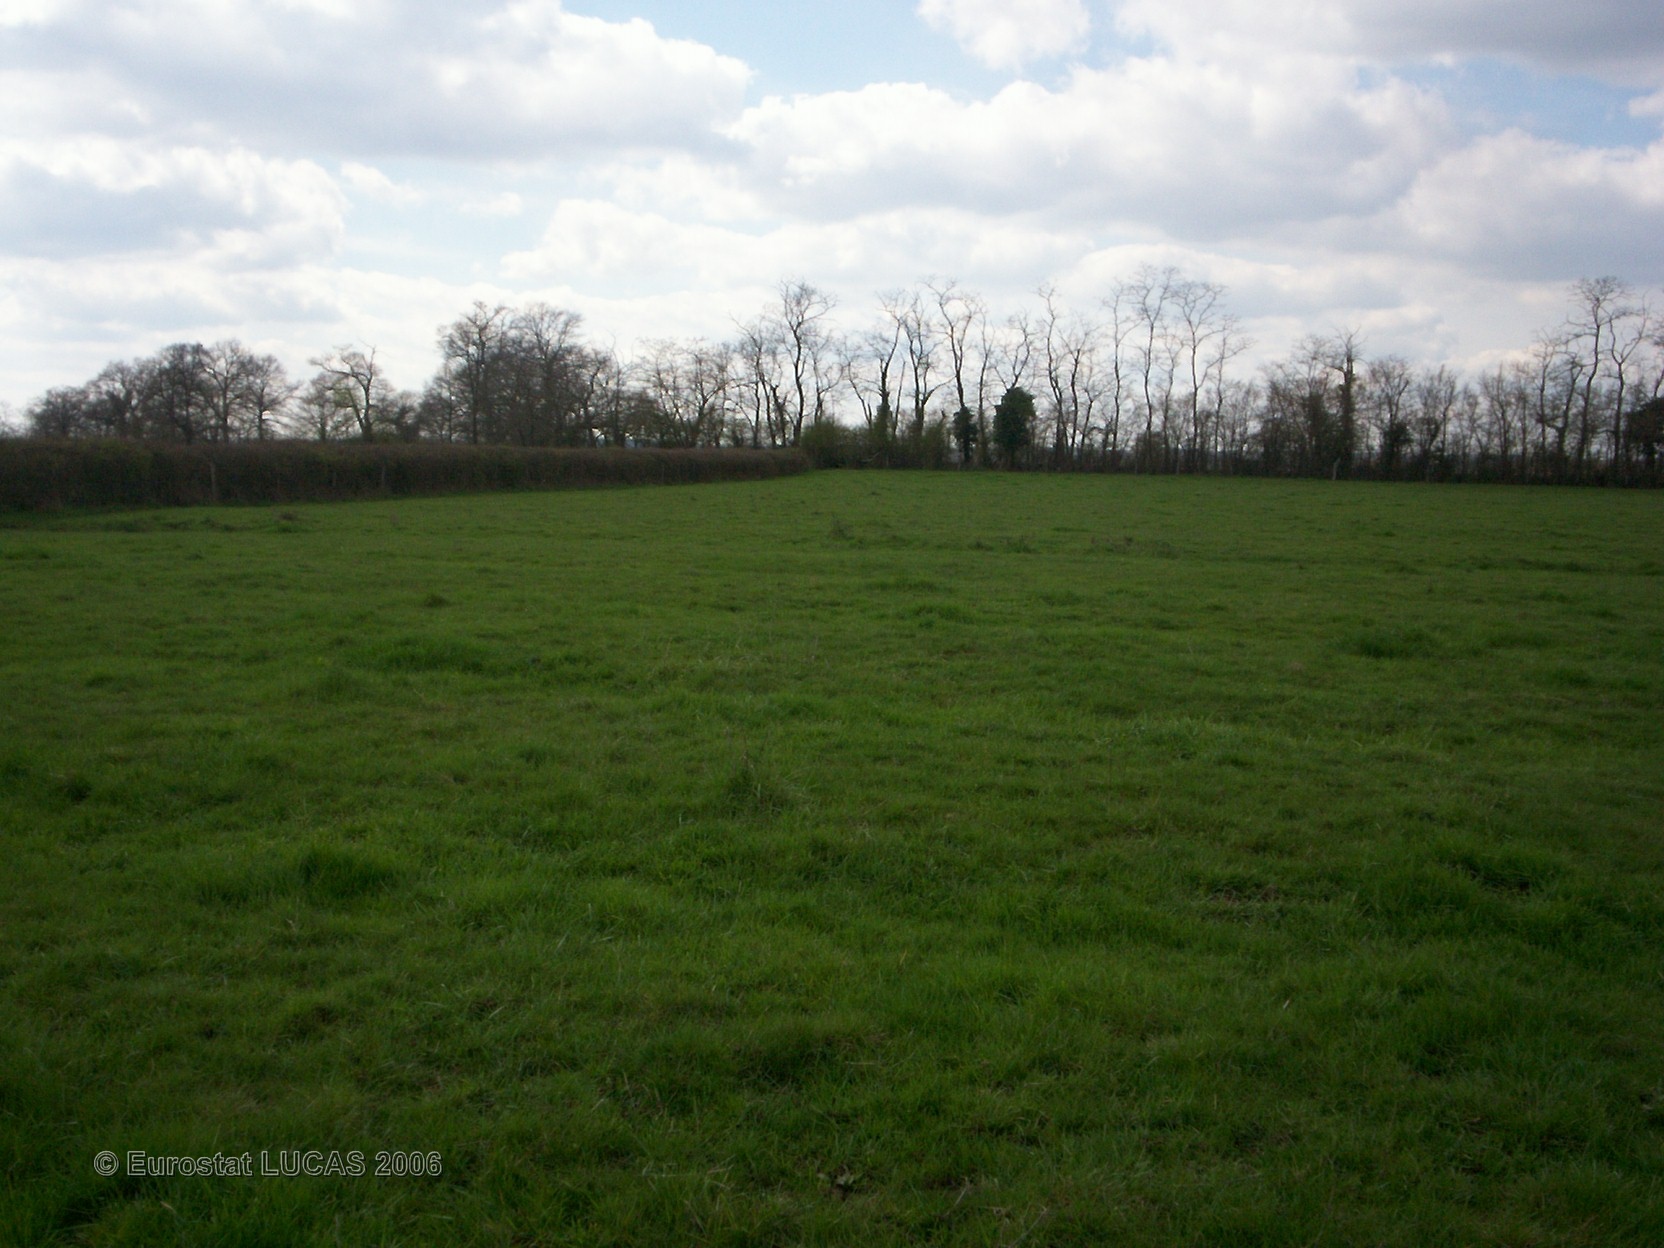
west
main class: Grassland
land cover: Grassland without tree/shrub cover
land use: Agriculture (excluding fallow land and kitchen gardens)
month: April
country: FR
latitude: 46.7948
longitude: 3.0660
